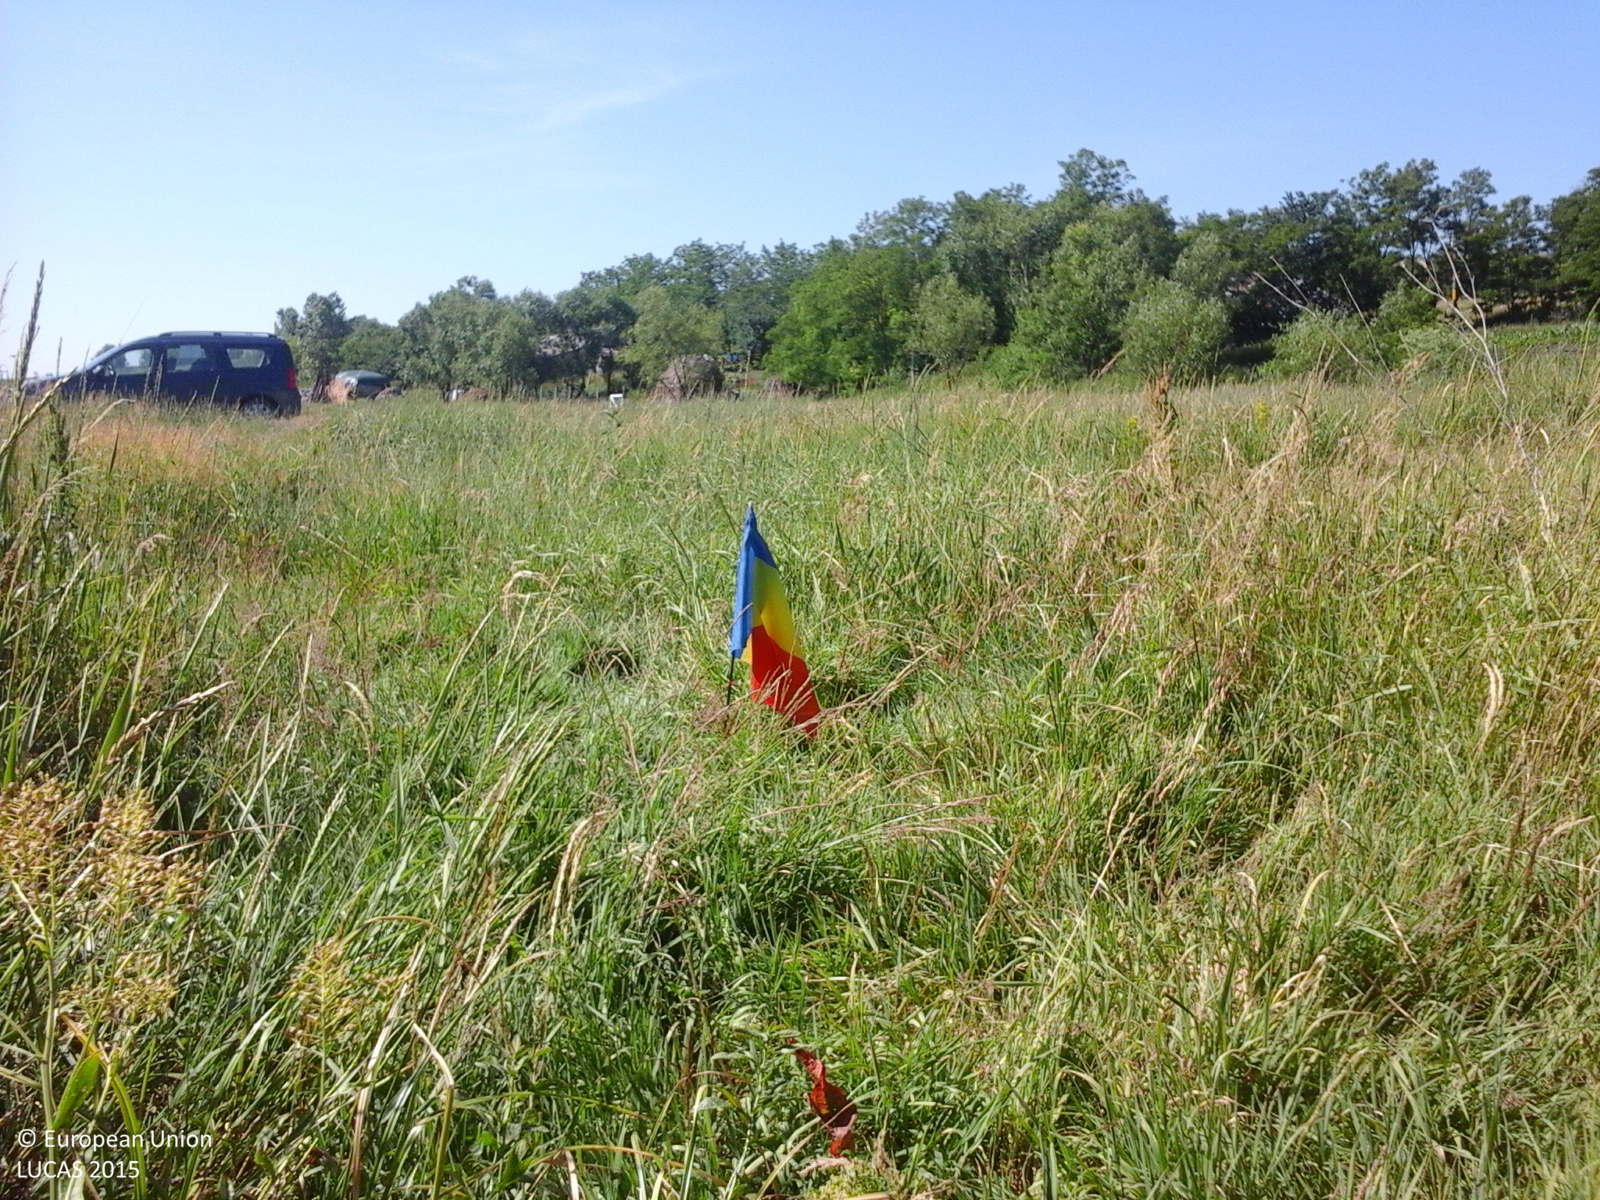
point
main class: Grassland
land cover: Grassland without tree/shrub cover
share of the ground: > 75 %
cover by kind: herbaceous plants 100 %
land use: Agriculture (excluding fallow land and kitchen gardens)
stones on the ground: < 10 %
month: June
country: RO
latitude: 47.7820
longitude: 26.8232
